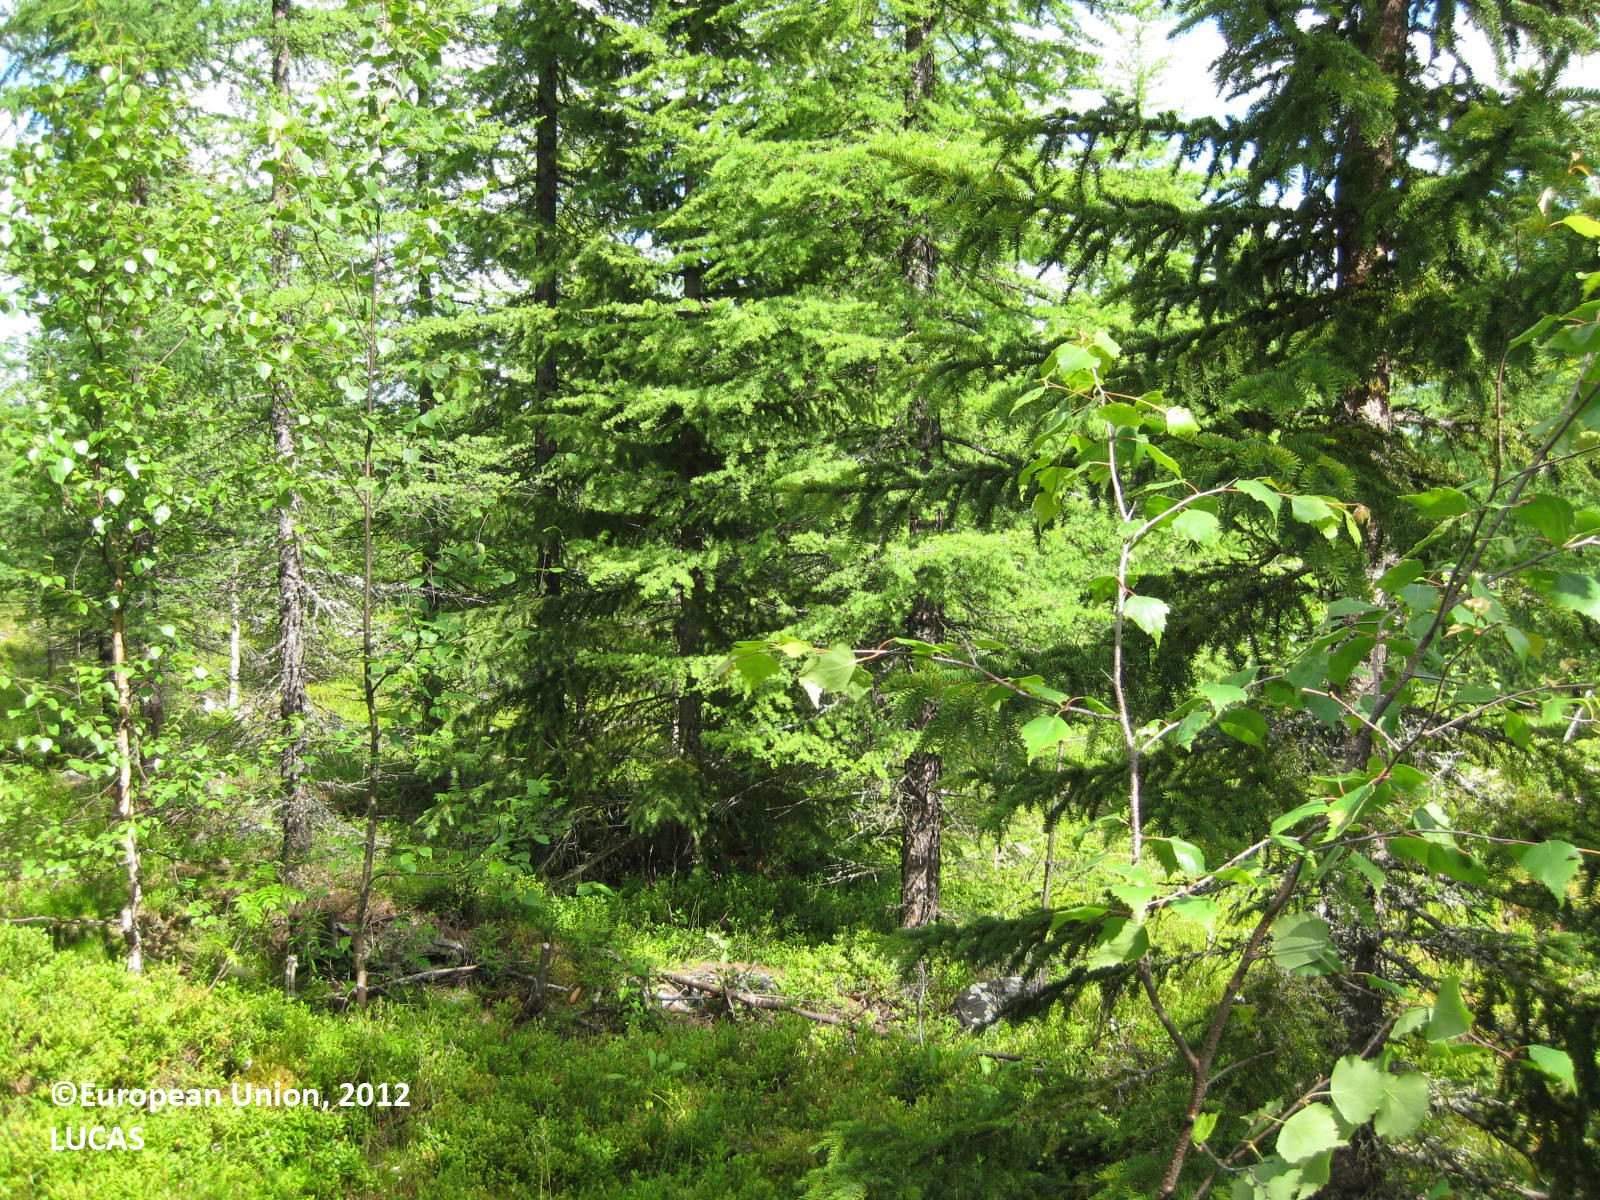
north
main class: Woodland
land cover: Other coniferous woodland
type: boreal forest
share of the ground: 50 - 75 %
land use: Forestry
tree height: > 5 m
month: July
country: FI
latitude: 65.6764
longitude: 28.0958
